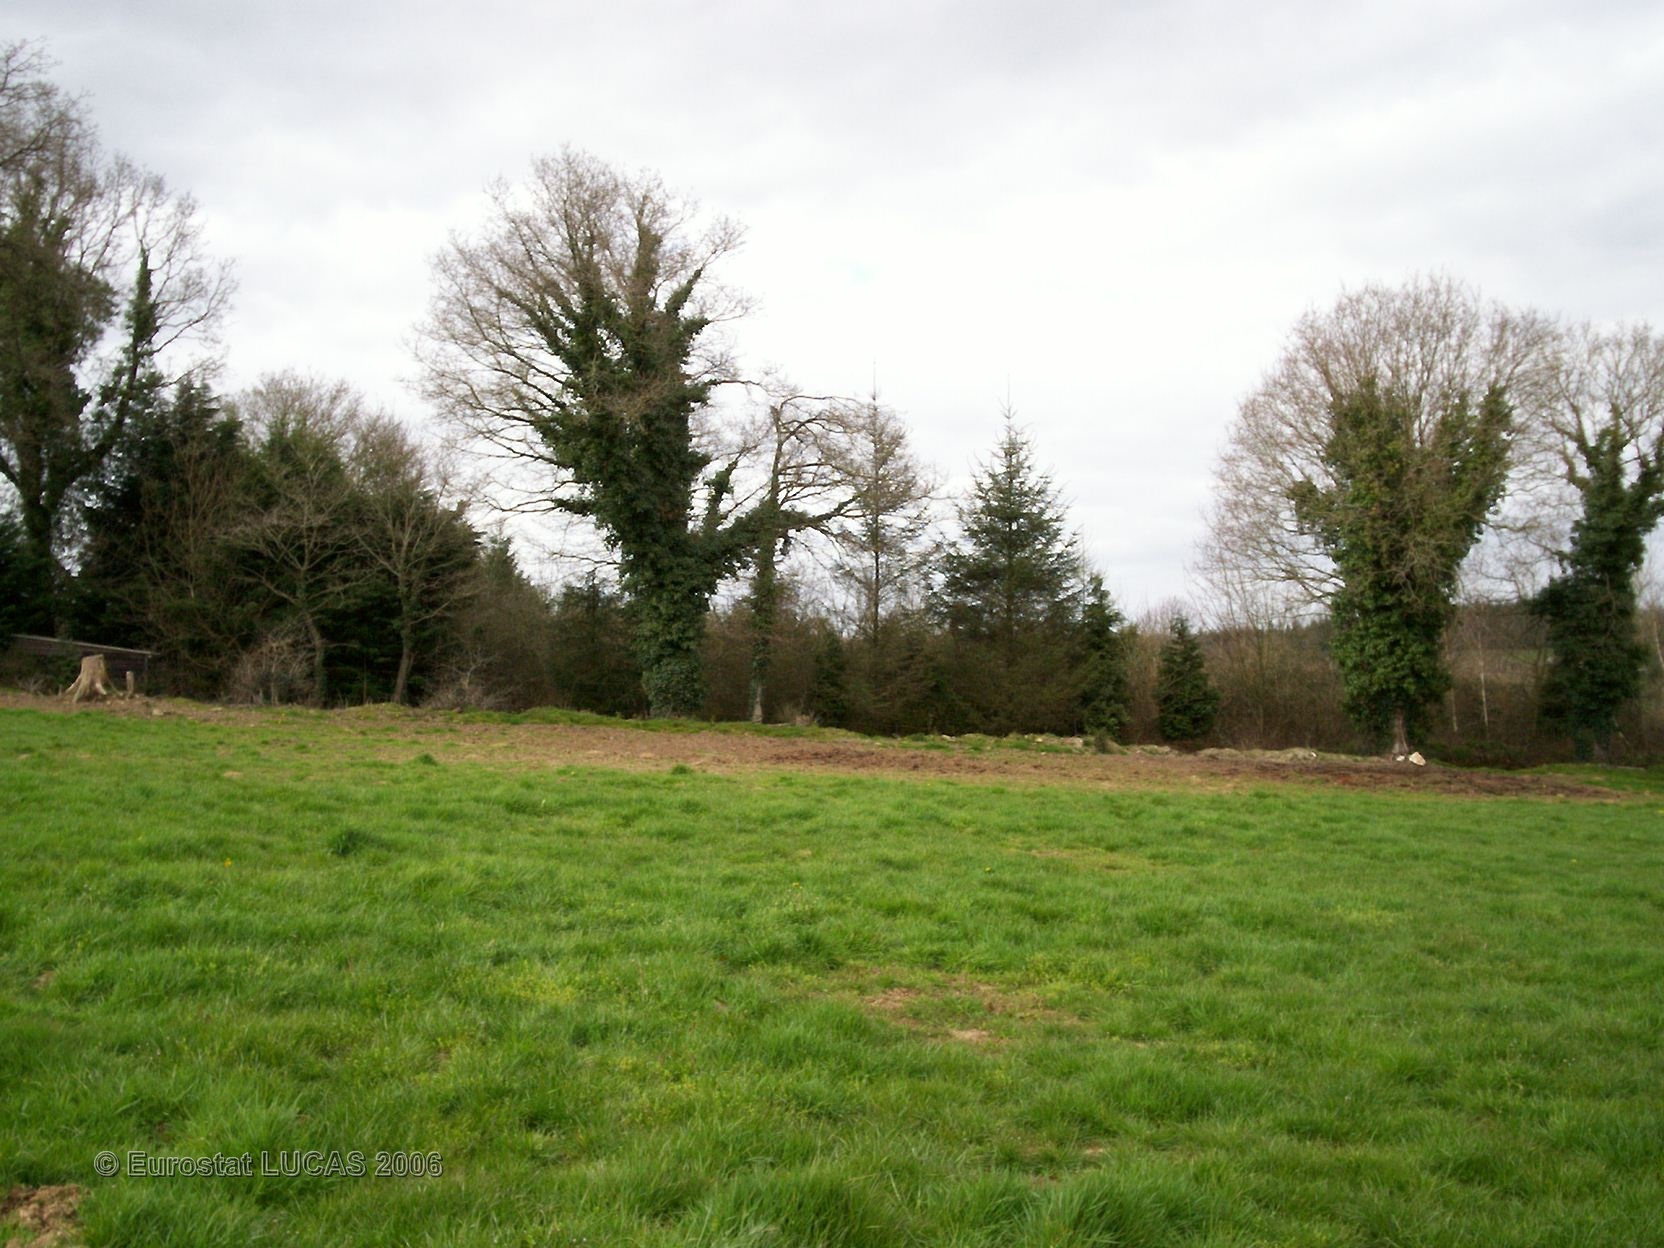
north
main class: Grassland
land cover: Grassland without tree/shrub cover
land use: Agriculture (excluding fallow land and kitchen gardens)
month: April
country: FR
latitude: 48.2079
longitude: -3.6584
